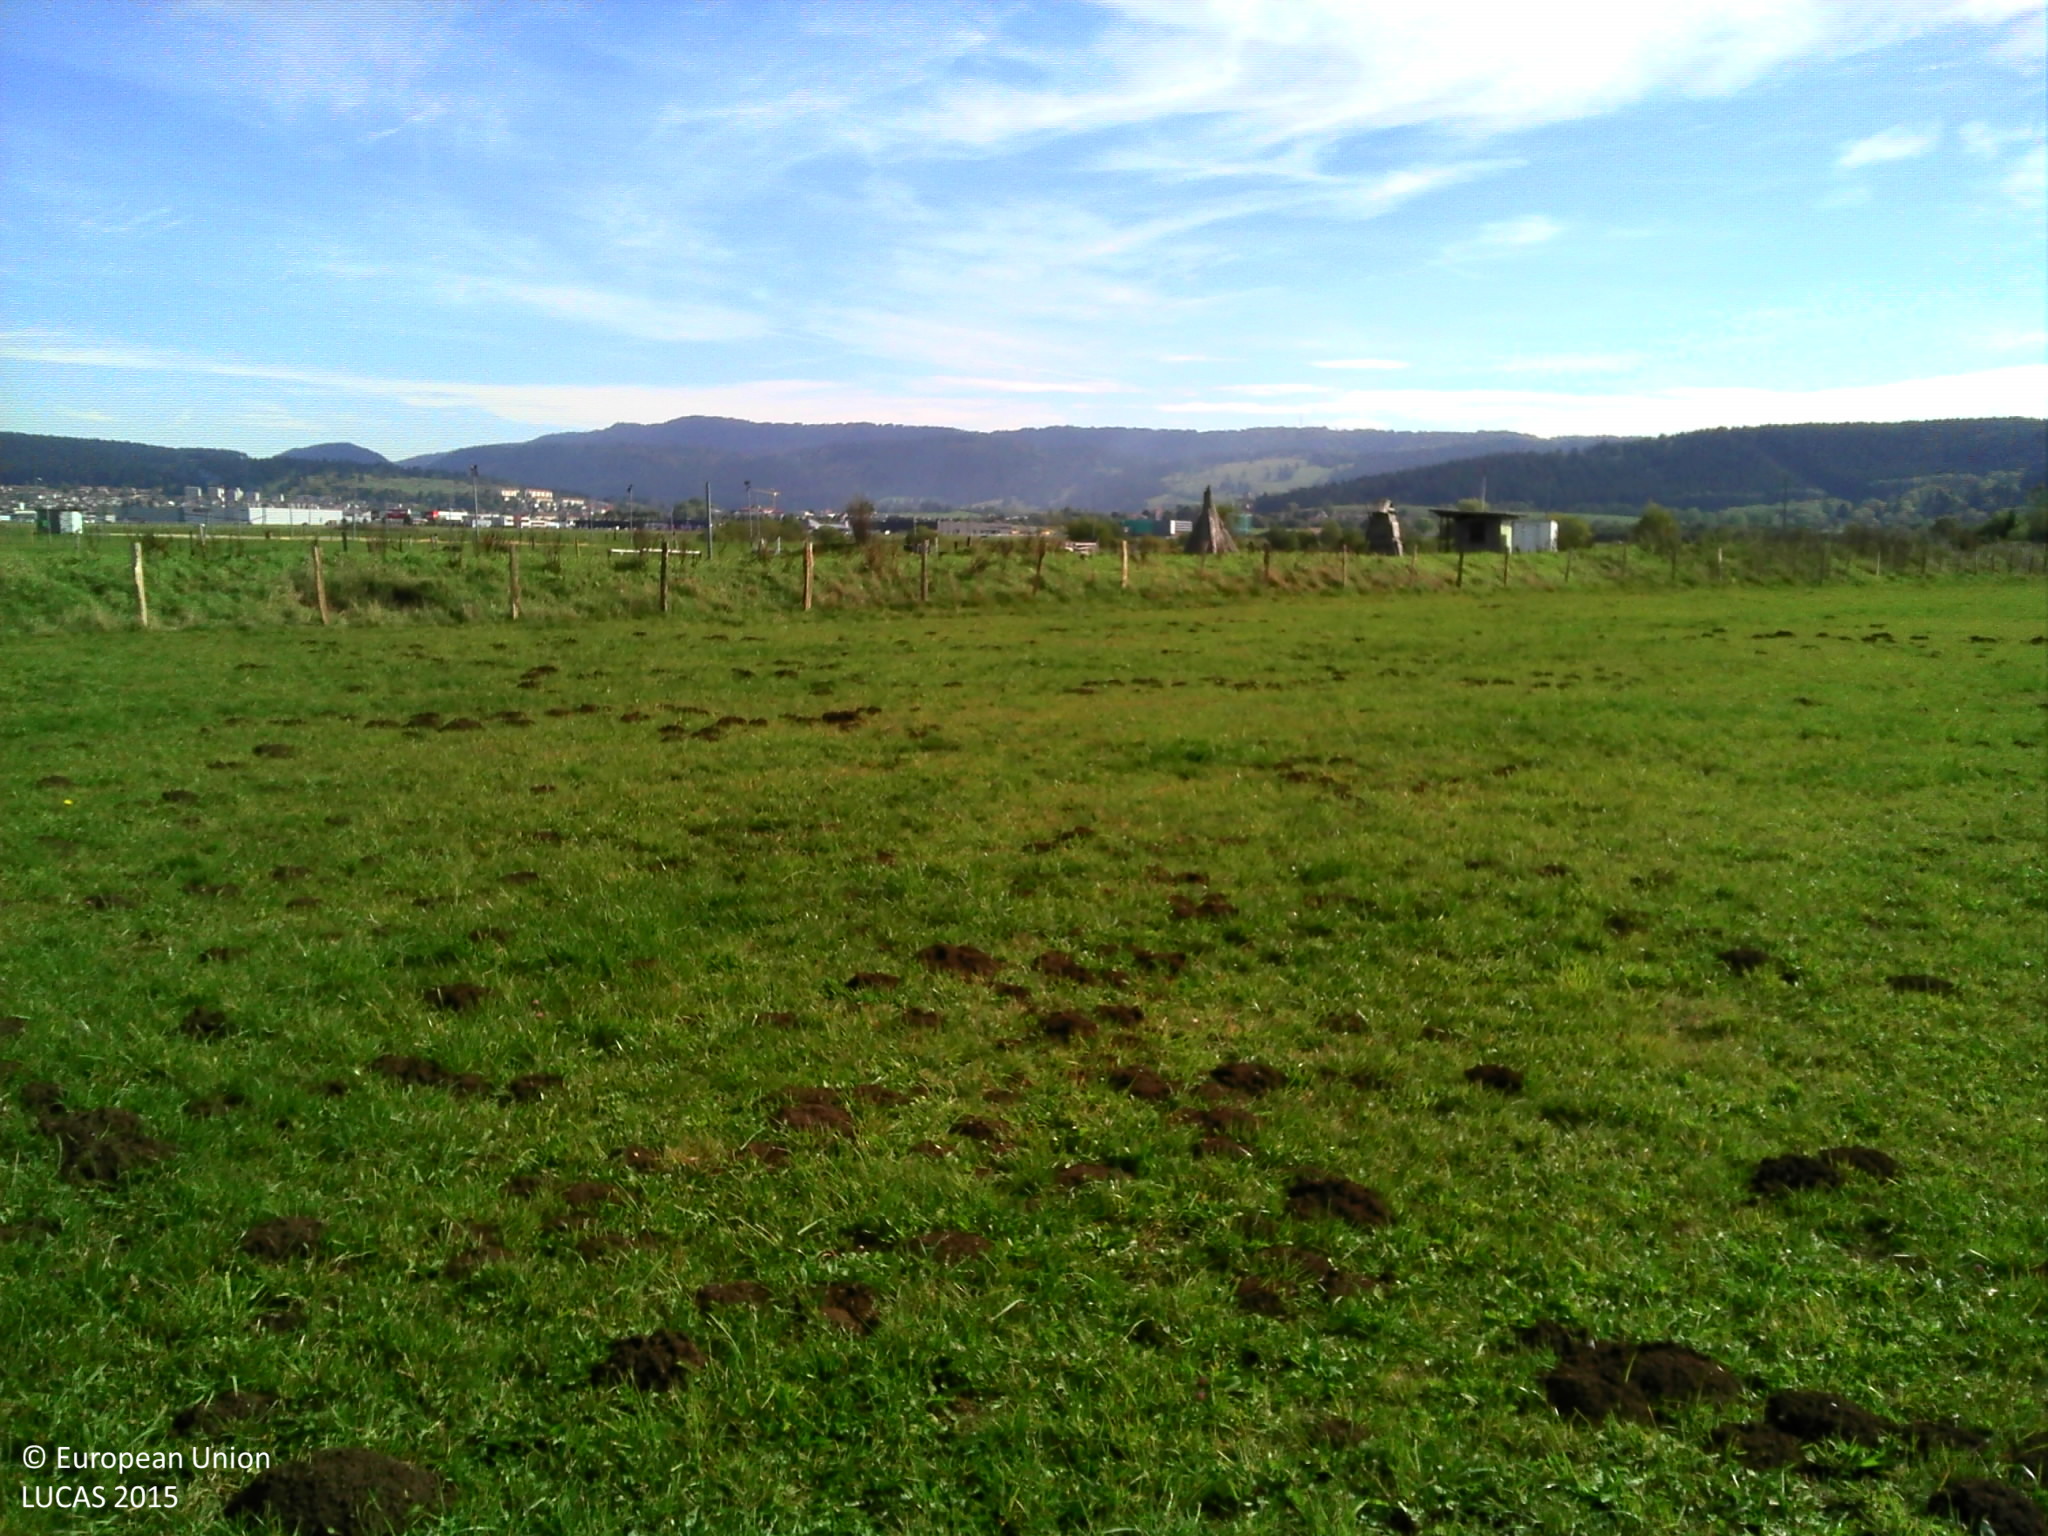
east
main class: Grassland
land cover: Grassland without tree/shrub cover
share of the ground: > 75 %
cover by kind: herbaceous plants 100 %
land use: Agriculture (excluding fallow land and kitchen gardens)
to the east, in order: Grassland without tree/shrub cover; Fences; Spontaneously vegetated surfaces; Grassland without tree/shrub cover; Tracks; Grassland without tree/shrub cover; Artificial constructions in urban areas; Grassland without tree/shrub cover; Tracks; Grassland without tree/shrub cover; Fences; Grass margins; Tracks; Grass margins; Broadleaved woodland; Inland fresh water bodies
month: October
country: FR
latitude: 46.9006
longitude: 6.3137
